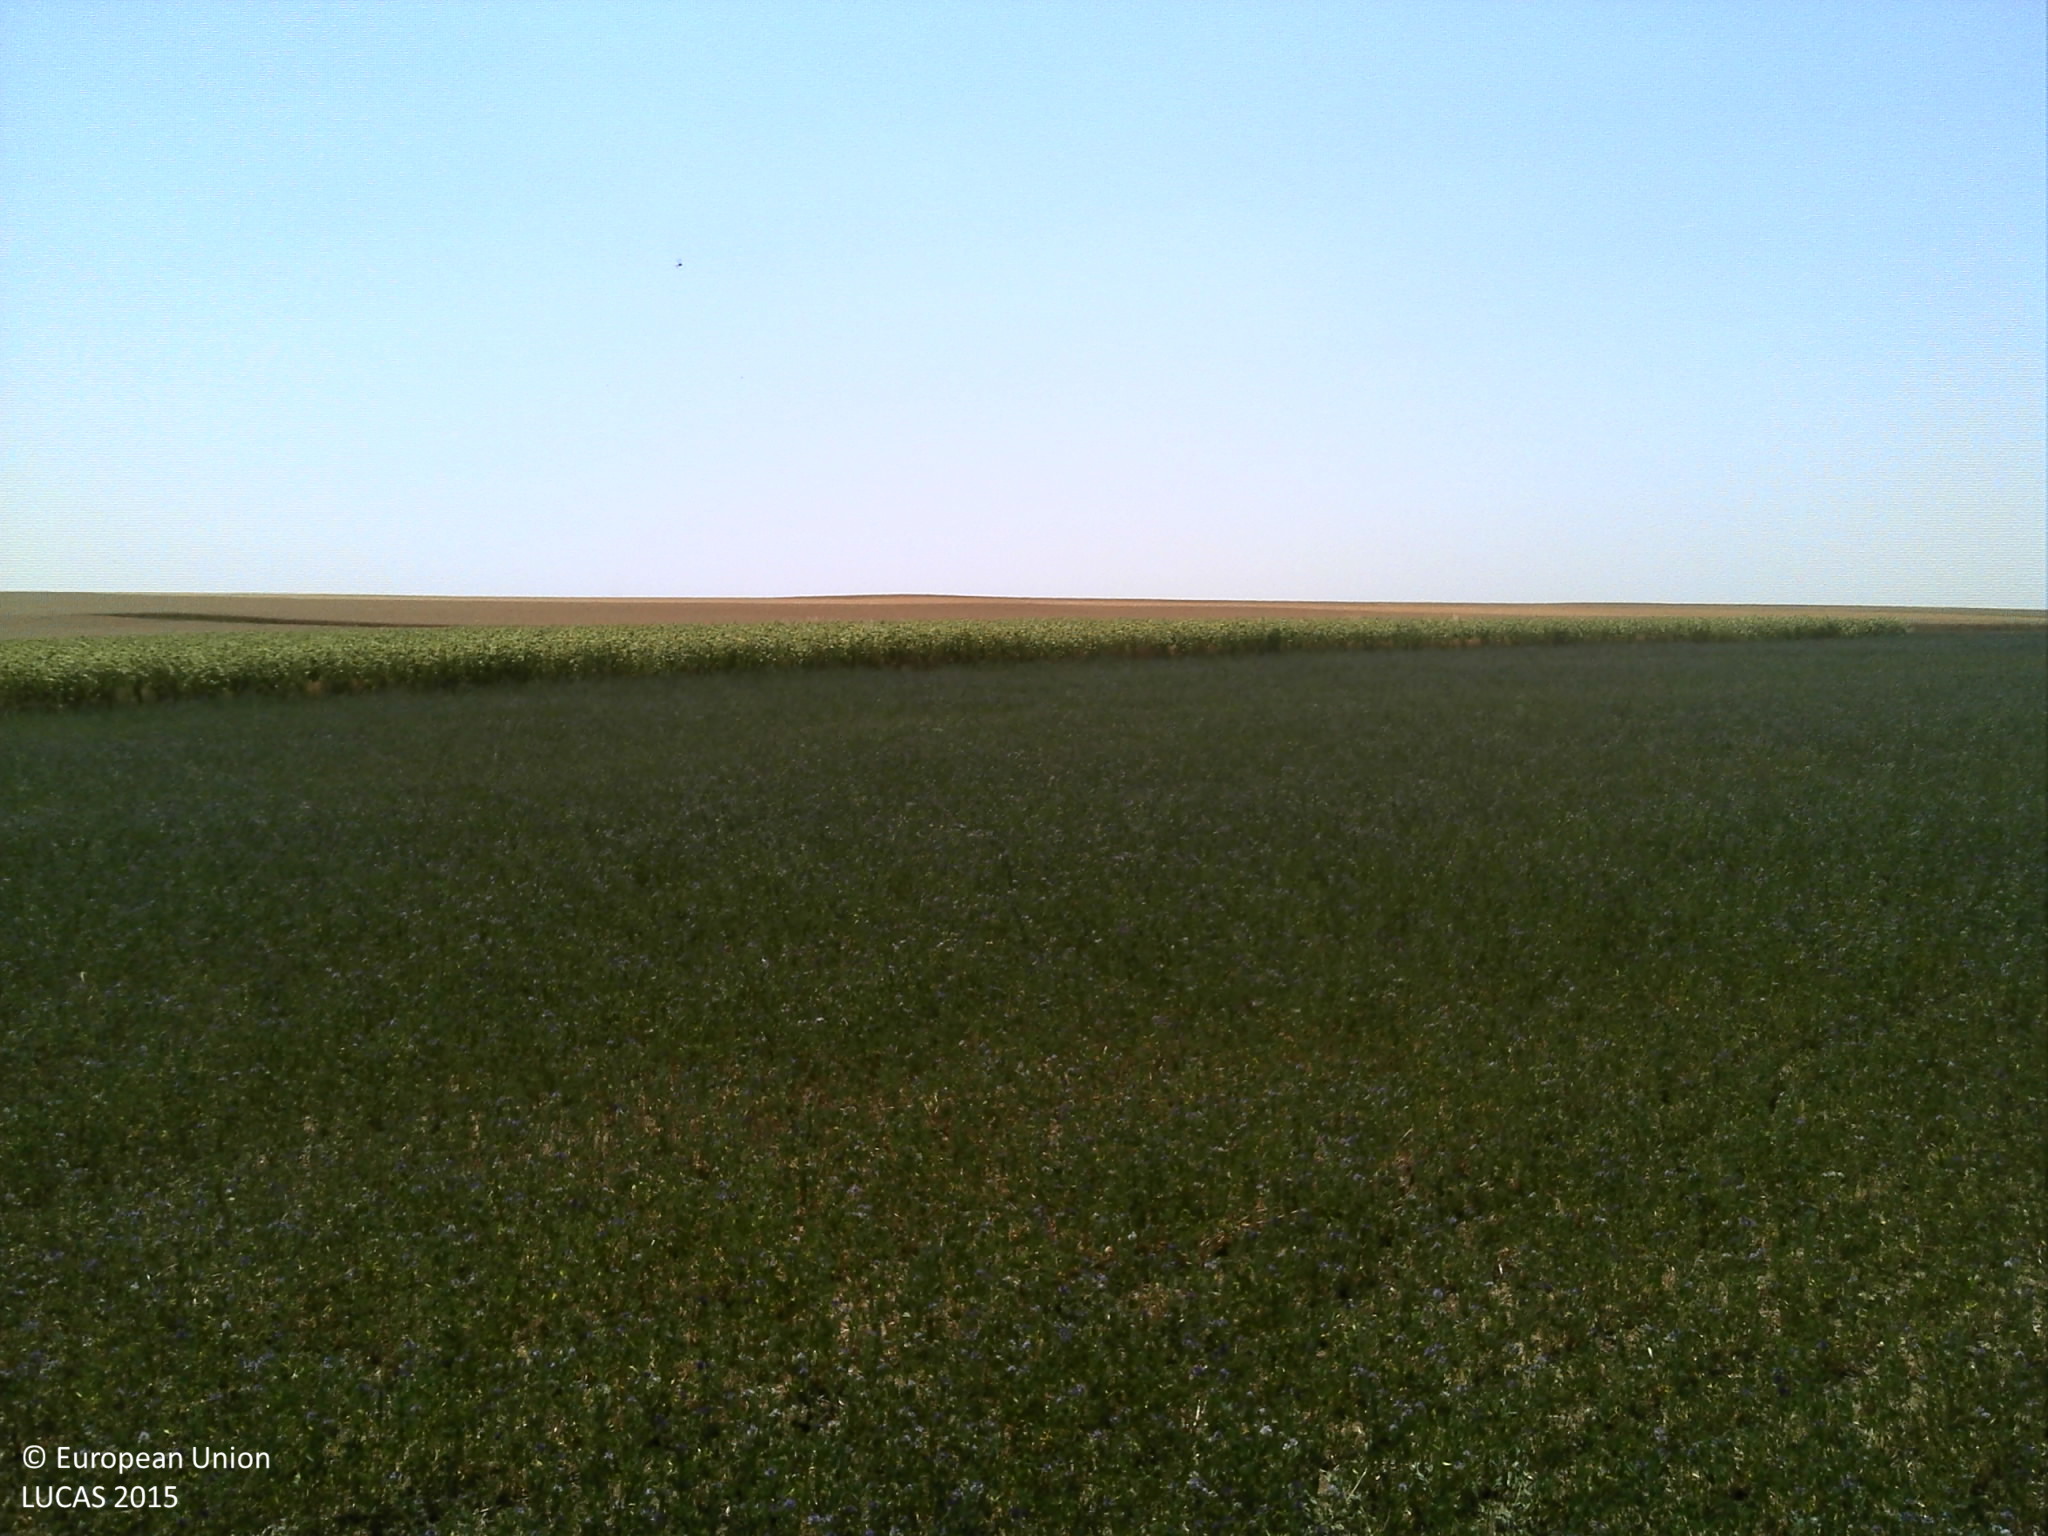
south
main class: Cropland
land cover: Lucerne
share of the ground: > 75 %
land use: Agriculture (excluding fallow land and kitchen gardens)
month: July
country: FR
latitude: 49.4561
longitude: 4.1320
